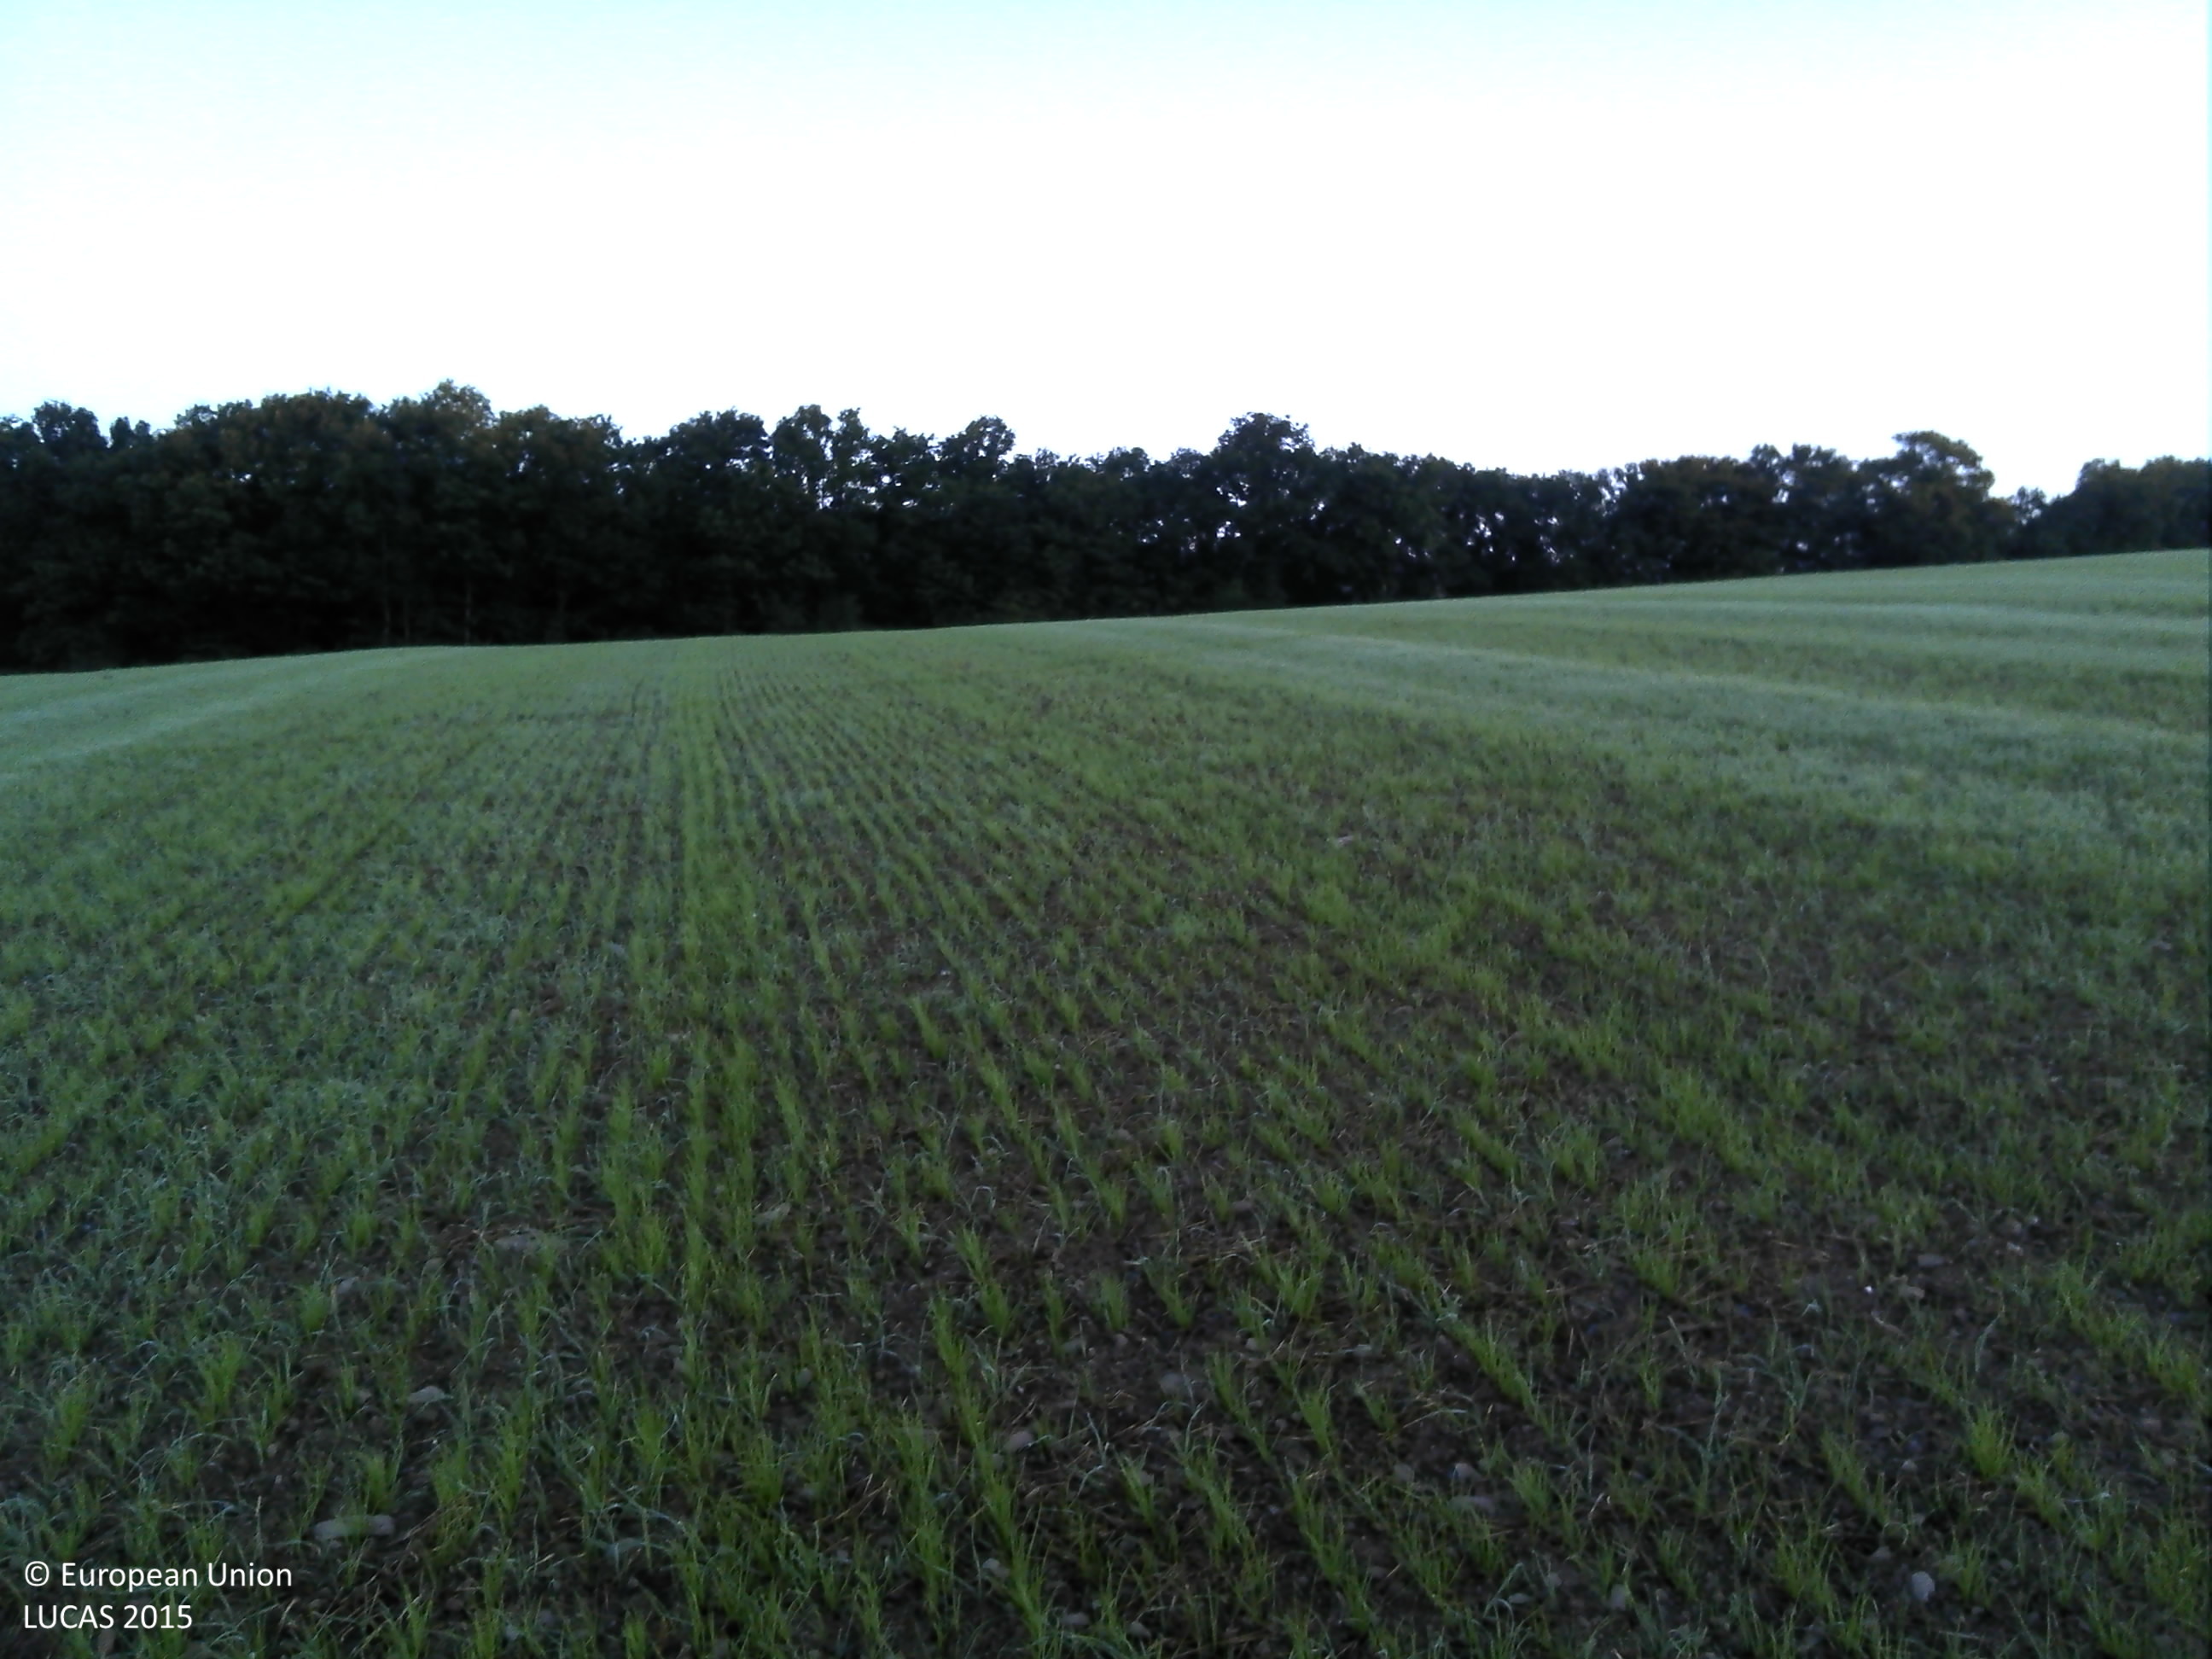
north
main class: Cropland
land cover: Temporary grasslands
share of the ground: 50 - 75 %
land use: Agriculture (excluding fallow land and kitchen gardens)
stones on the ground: 10 - 25 %
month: September
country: FR
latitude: 48.2575
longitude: -3.6994
